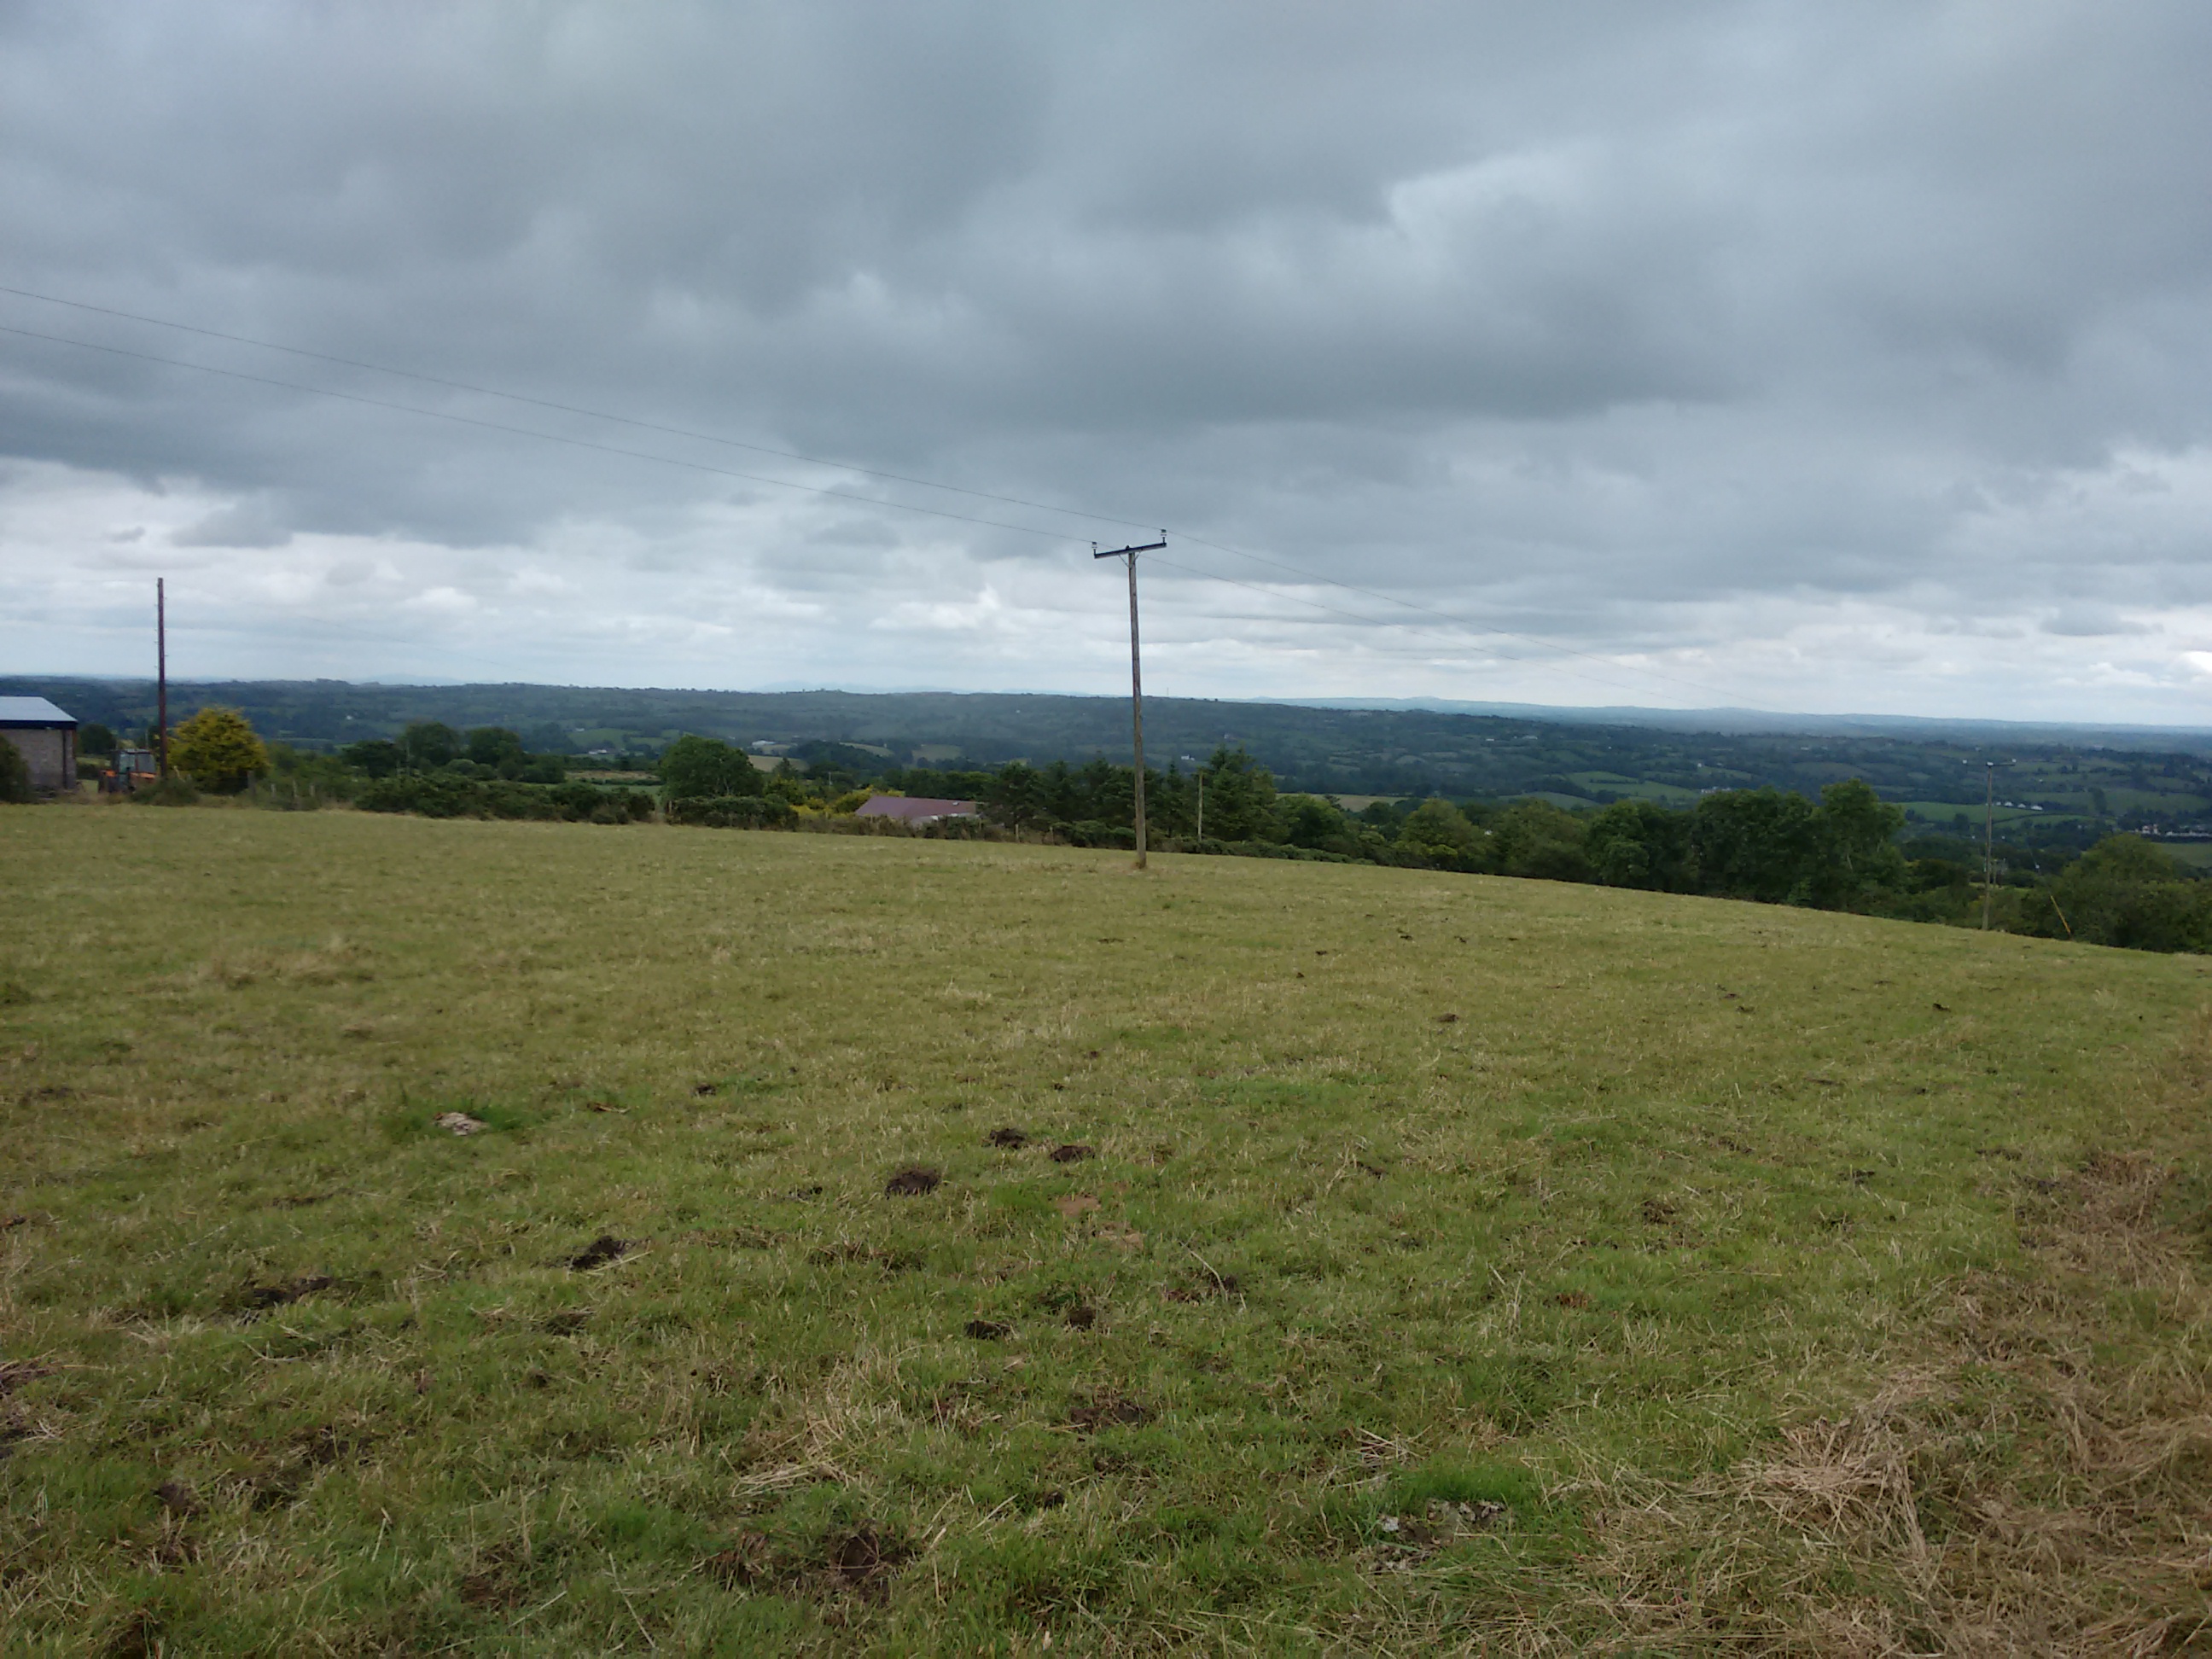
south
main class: Grassland
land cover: Grassland without tree/shrub cover
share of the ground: > 75 %
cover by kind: herbaceous plants 100 %
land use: Agriculture (excluding fallow land and kitchen gardens)
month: July
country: GB
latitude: 54.4819
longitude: -7.0418
